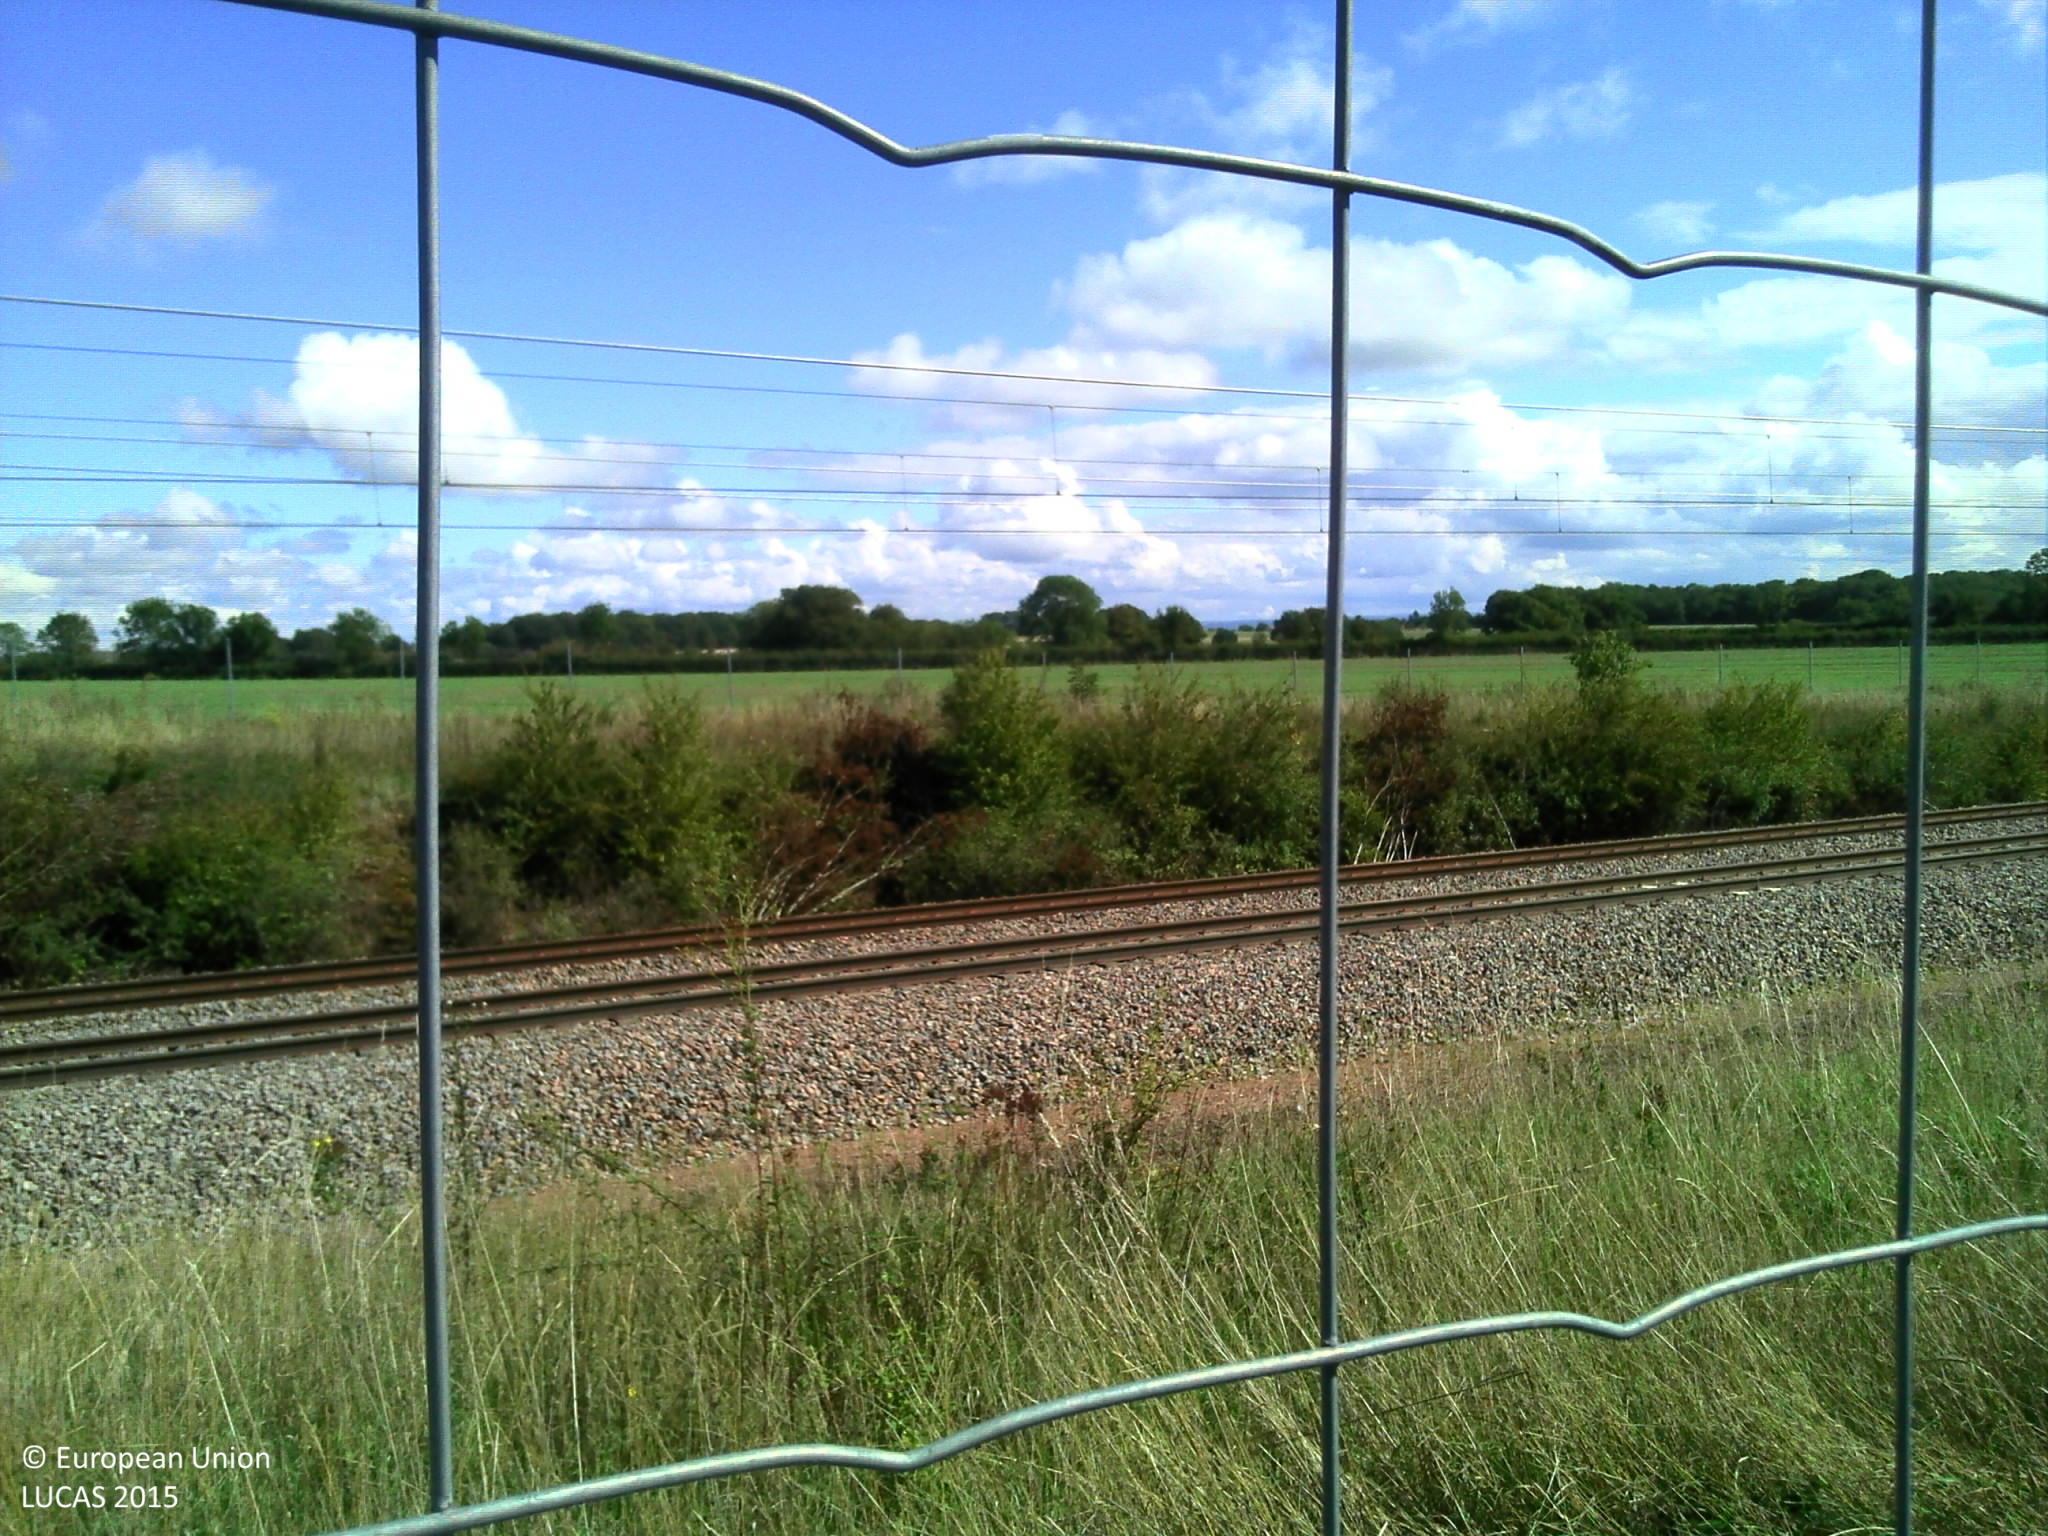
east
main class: Grassland
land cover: Grassland without tree/shrub cover
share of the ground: > 75 %
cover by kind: herbaceous plants 100 %
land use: Railway transport
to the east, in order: Grassland without tree/shrub cover; Electric lines; Railways; Electric lines; Grassland without tree/shrub cover; Abandoned hedges; Grassland without tree/shrub cover; Fences; Spontaneously vegetated surfaces; Managed hedges; Grassland without tree/shrub cover
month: September
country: FR
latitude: 47.2105
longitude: 4.3088
